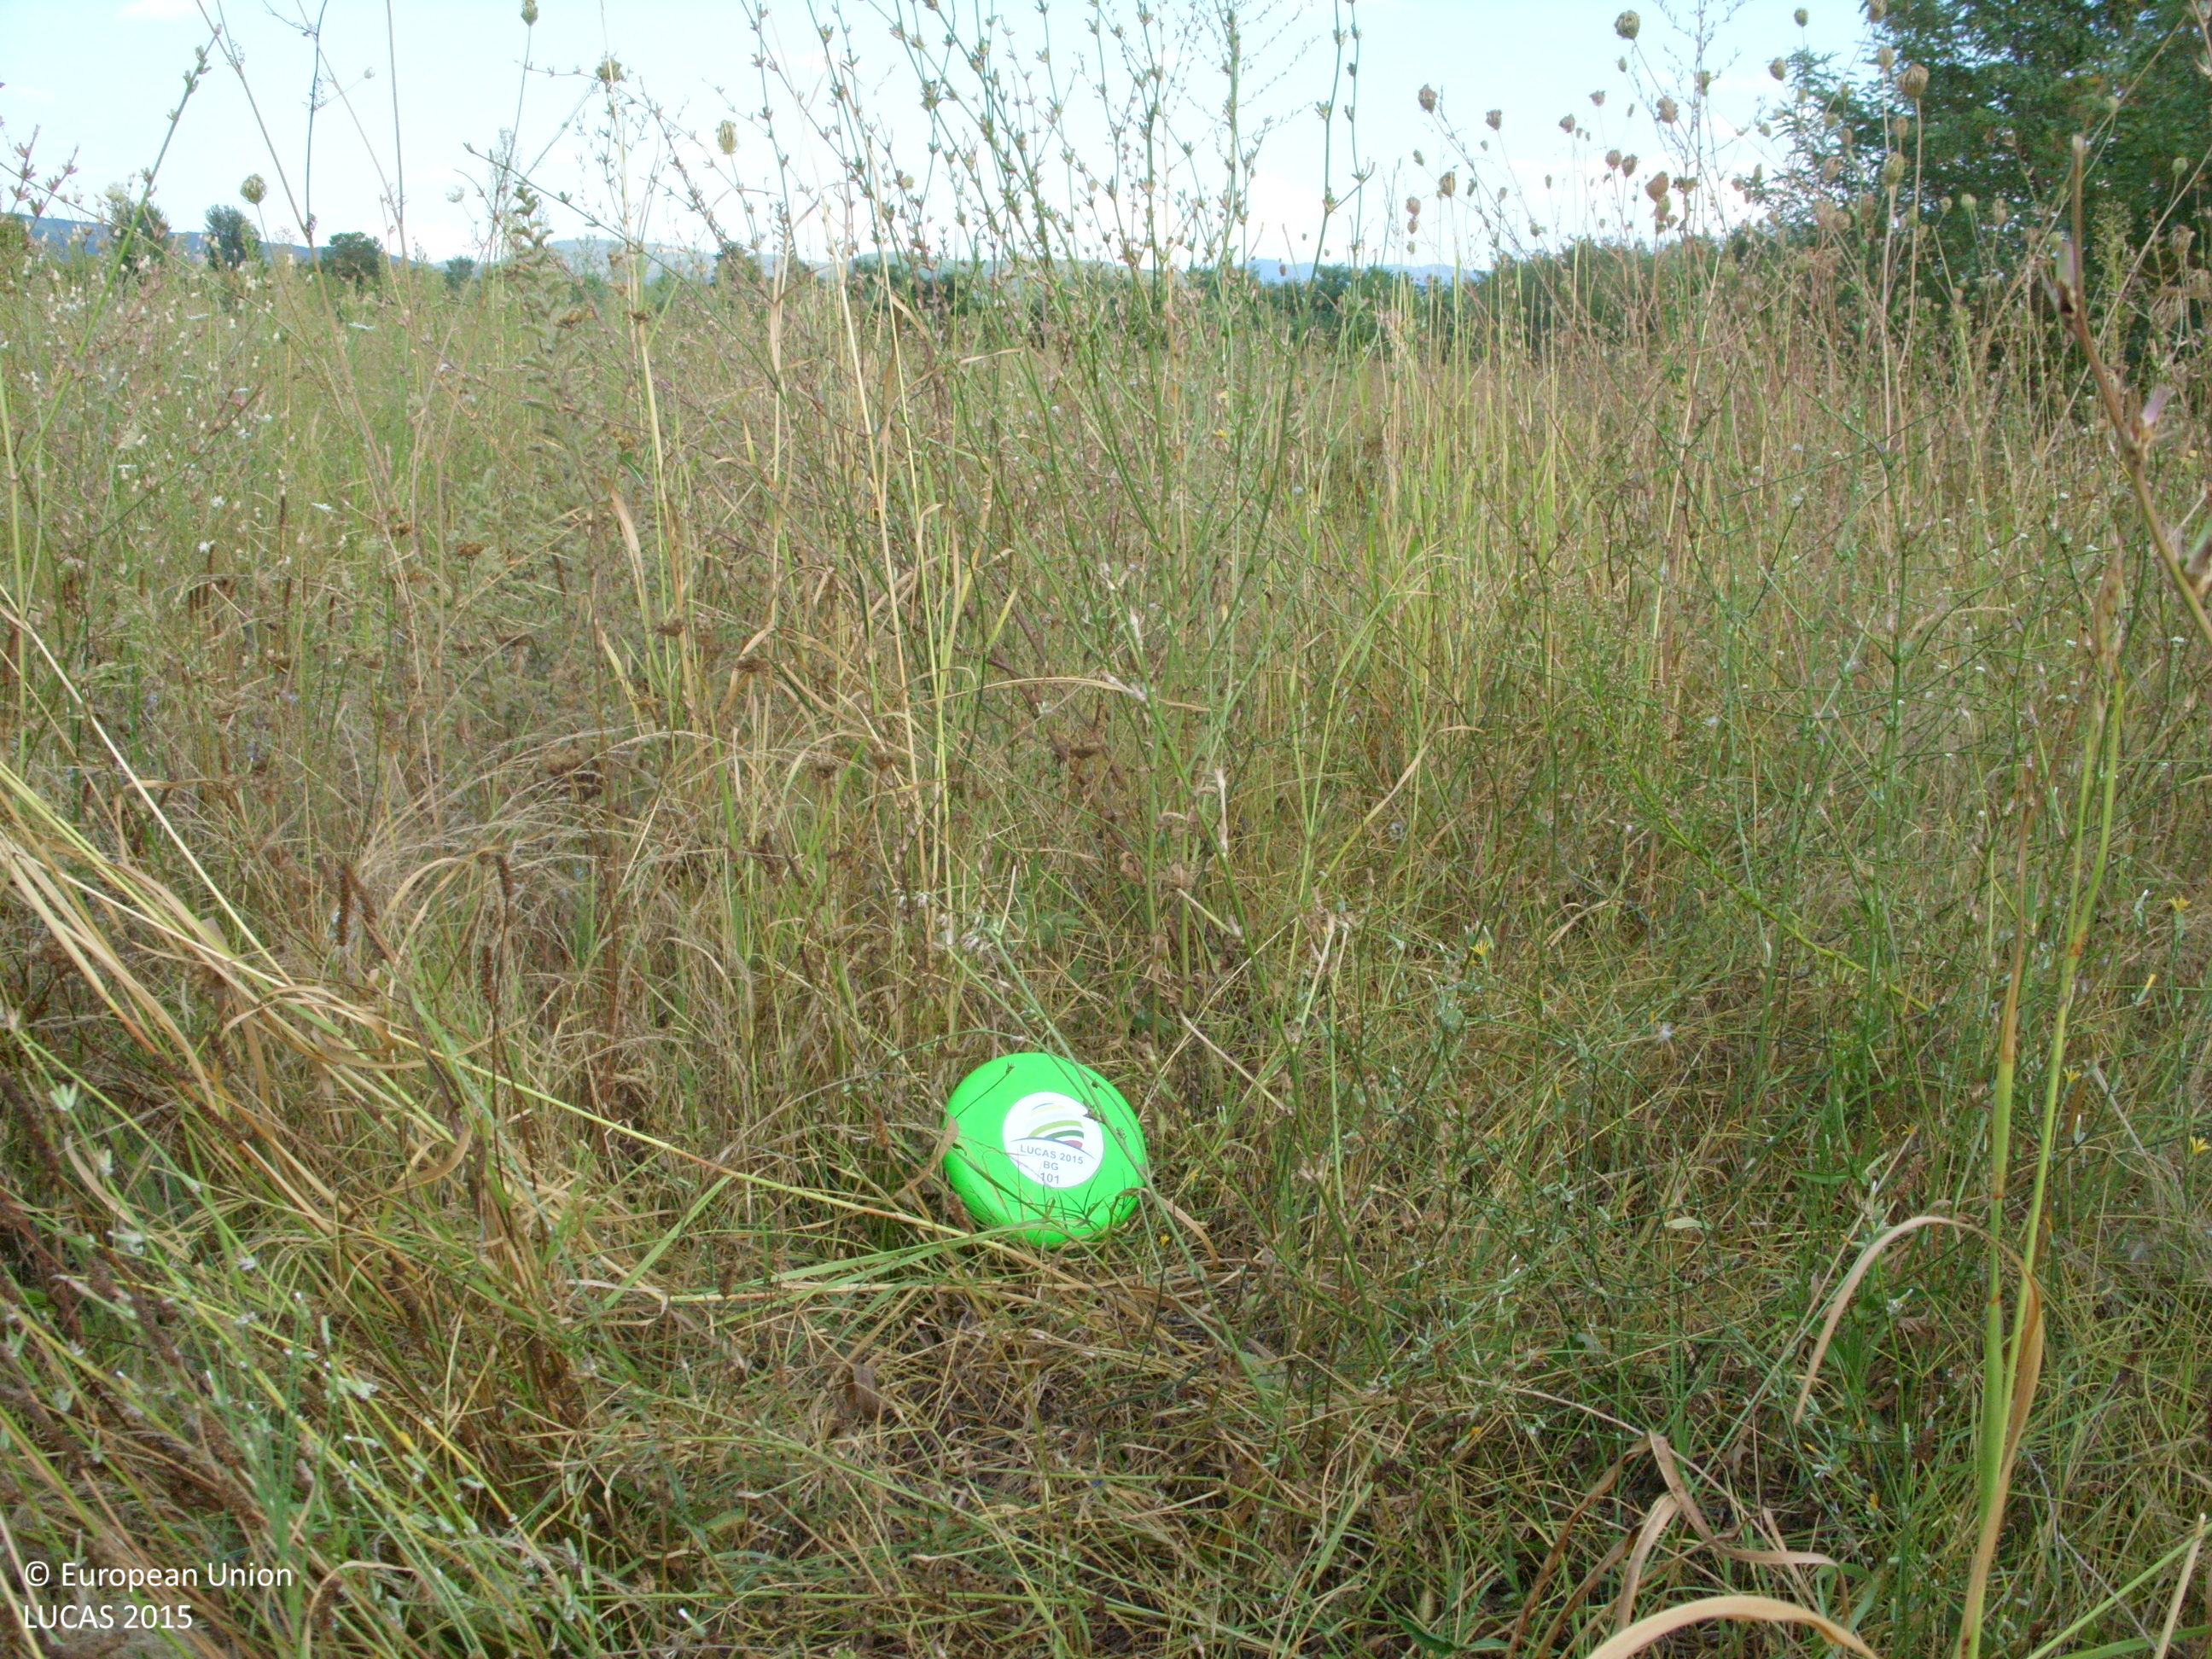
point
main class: Grassland
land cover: Spontaneously vegetated surfaces
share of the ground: > 75 %
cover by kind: herbaceous plants 100 %
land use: Fallow land
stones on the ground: < 10 %
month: August
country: BG
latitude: 42.6124
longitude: 24.8704
